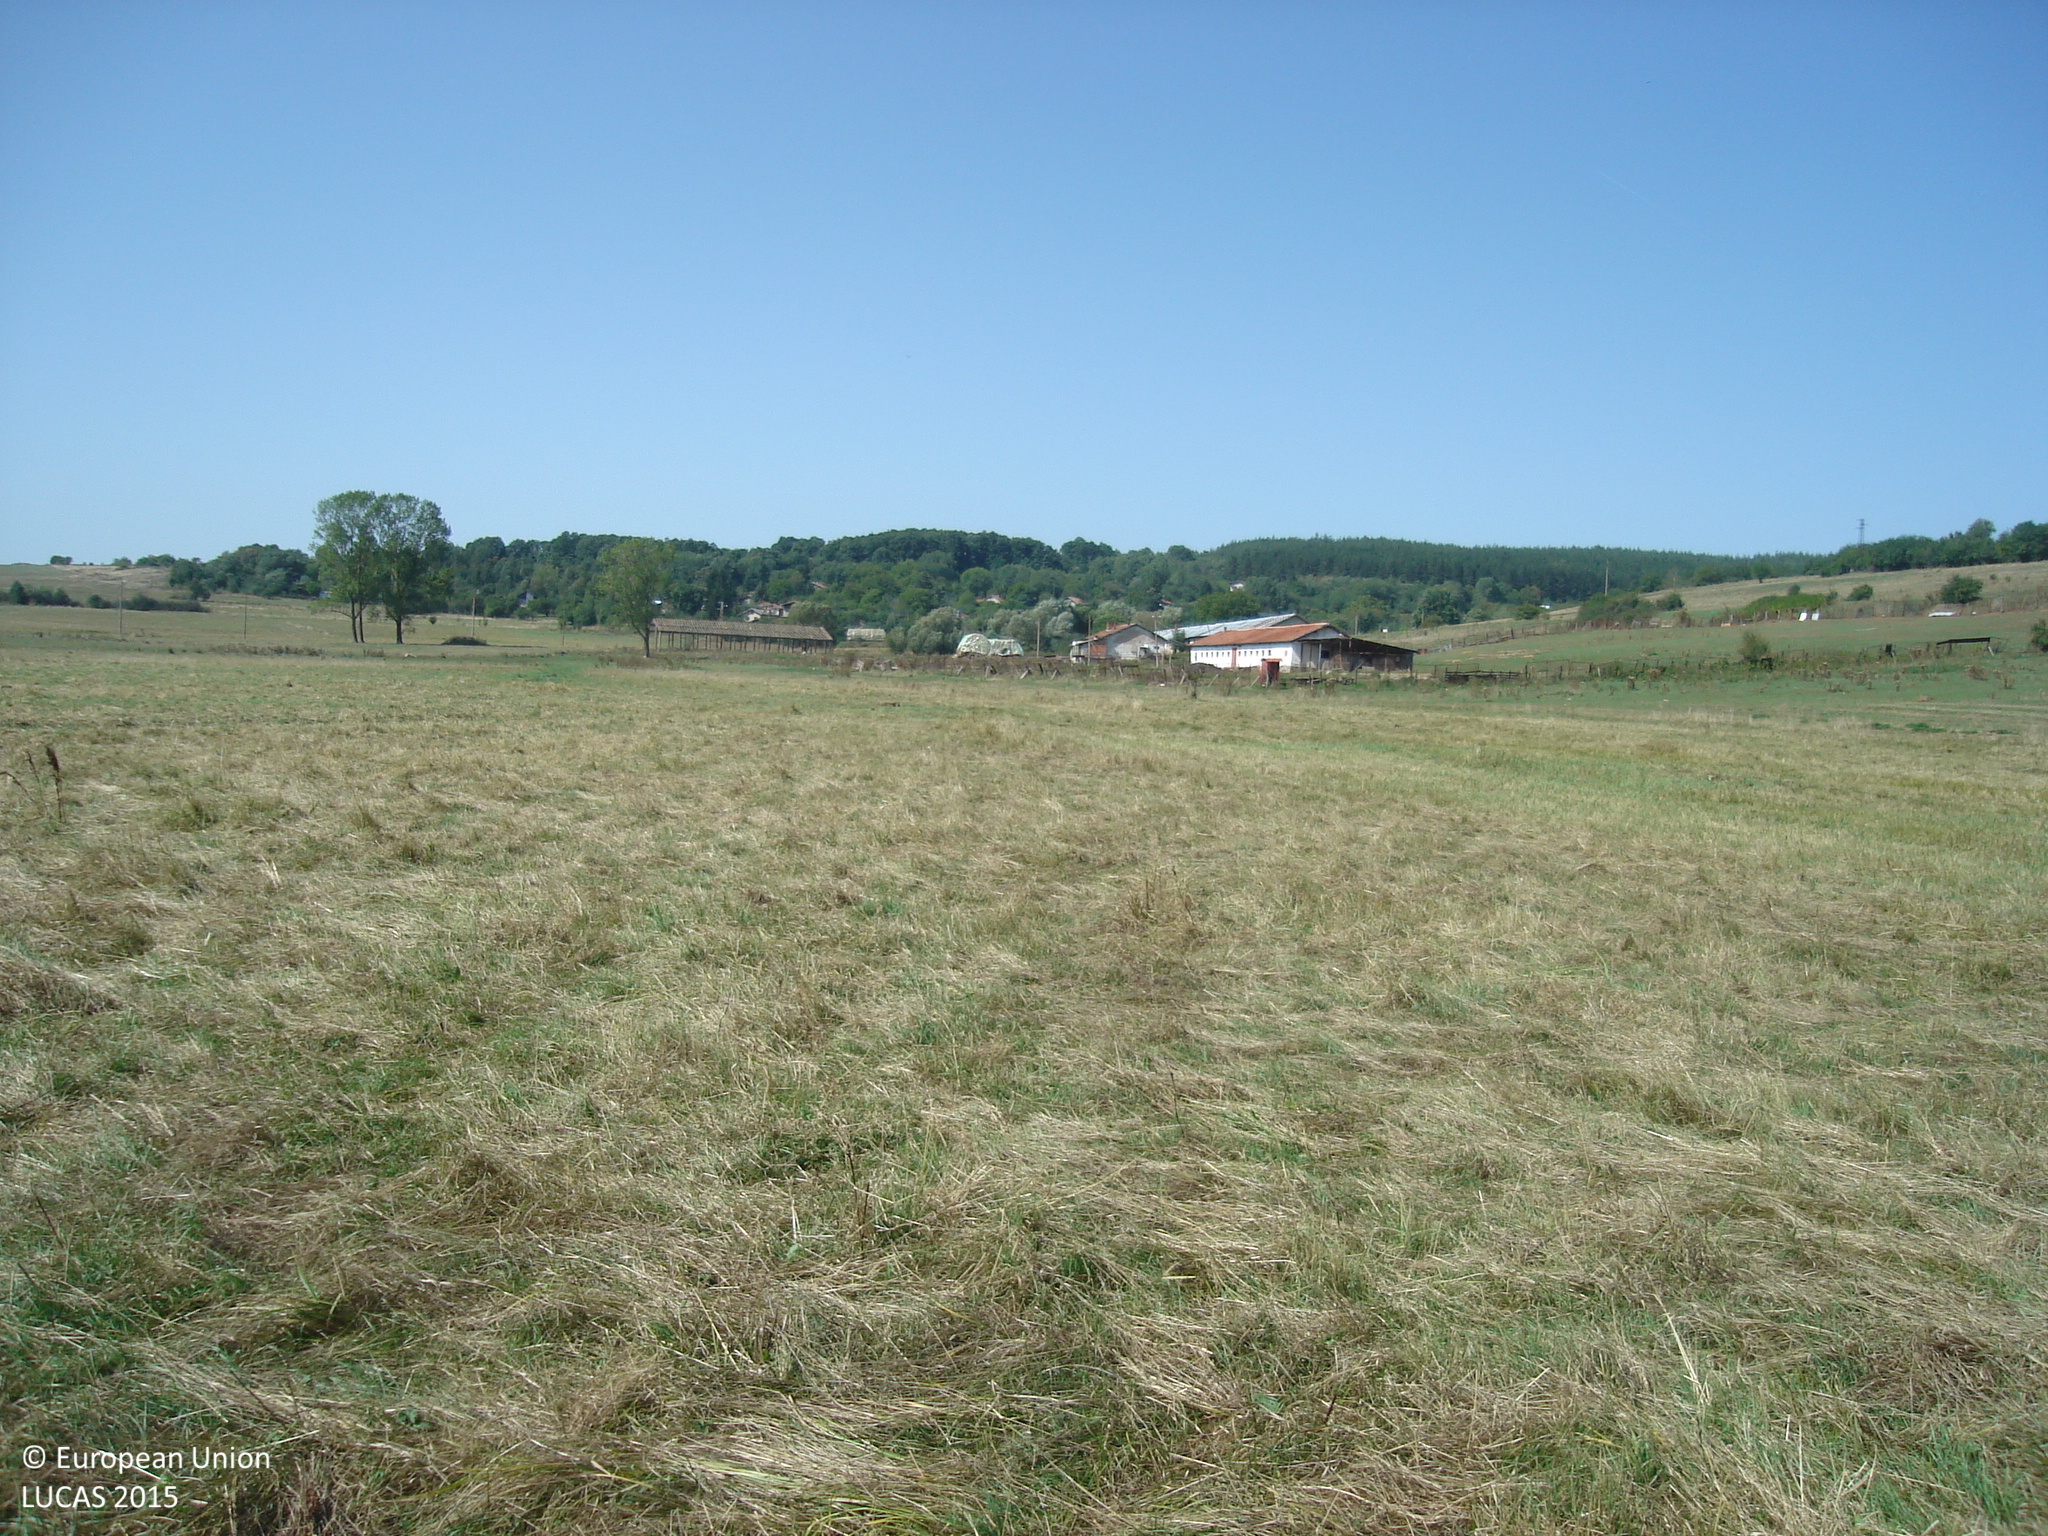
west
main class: Grassland
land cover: Grassland without tree/shrub cover
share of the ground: > 75 %
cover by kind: herbaceous plants 100 %
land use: Agriculture (excluding fallow land and kitchen gardens)
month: September
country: BG
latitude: 42.9485
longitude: 23.1114
